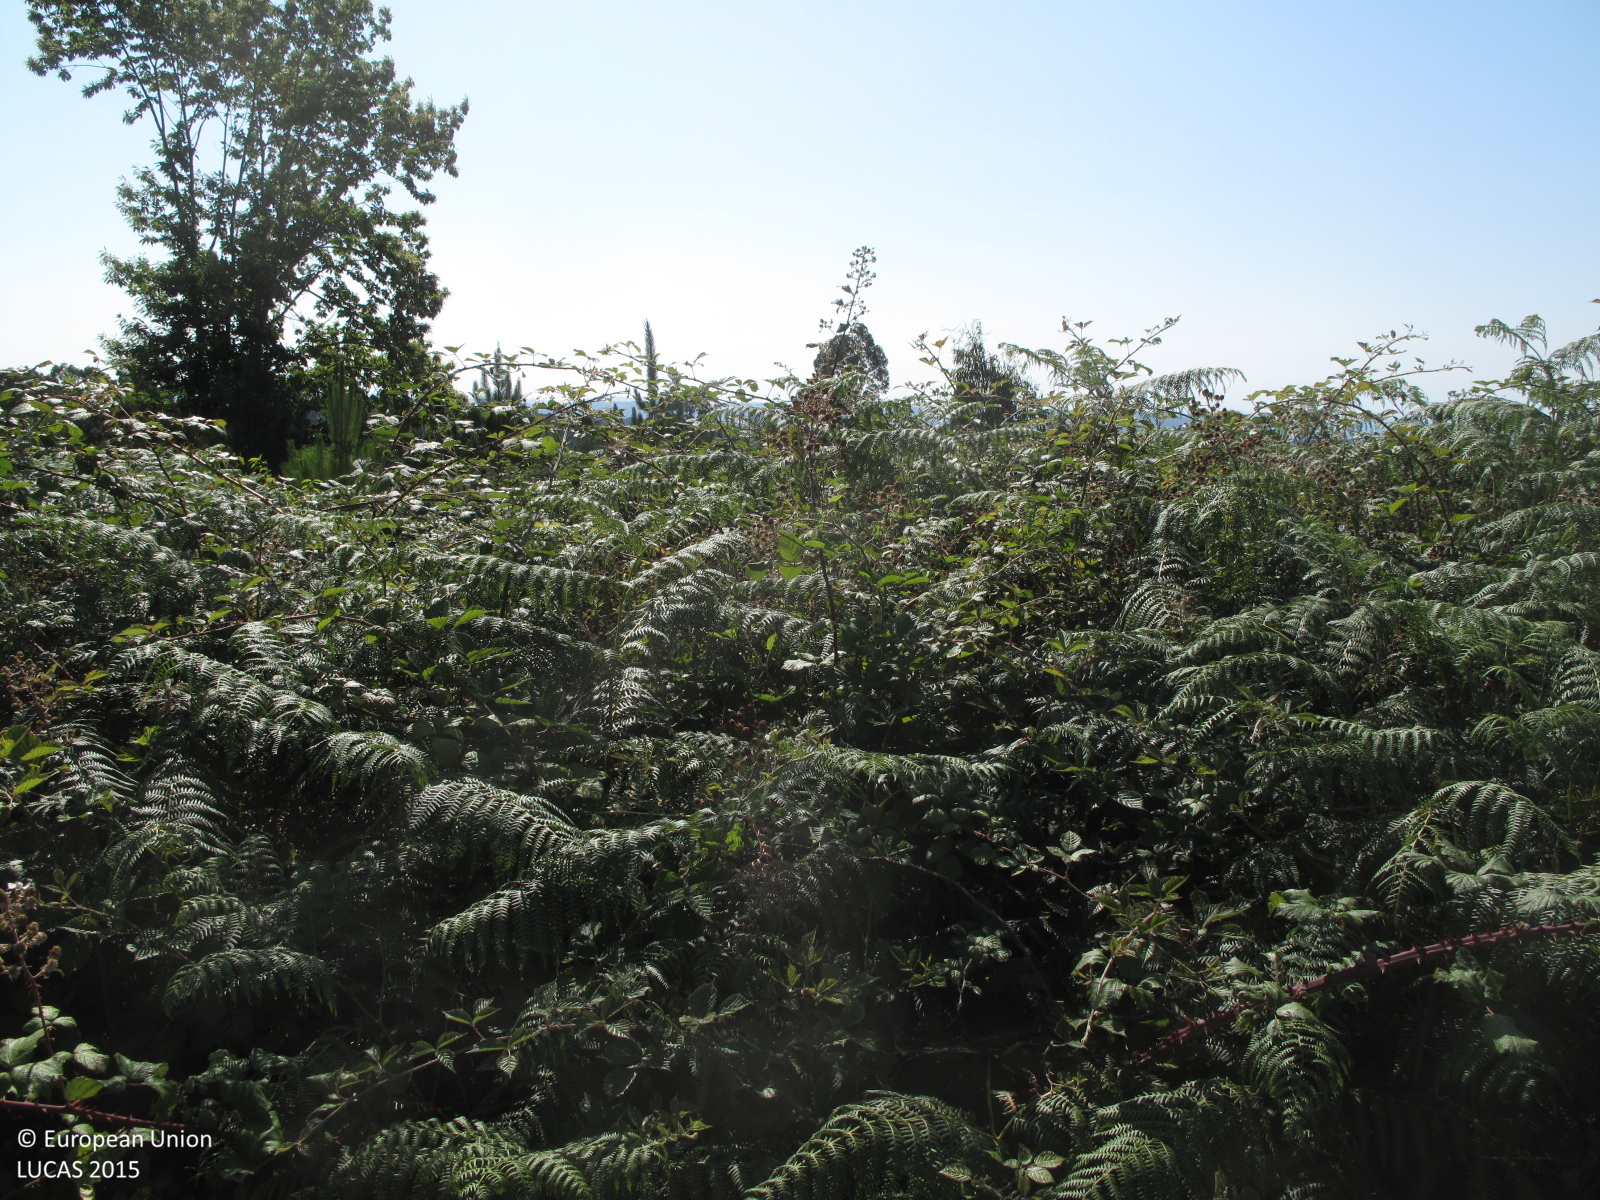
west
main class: Shrubland
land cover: Shrubland with sparse tree cover
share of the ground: 10 - 25 %
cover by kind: herbaceous plants 75 %, shrubs 20 %, broadleaved forest trees 5 %
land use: Abandoned areas
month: July
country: ES
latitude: 43.3431
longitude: -8.1455
